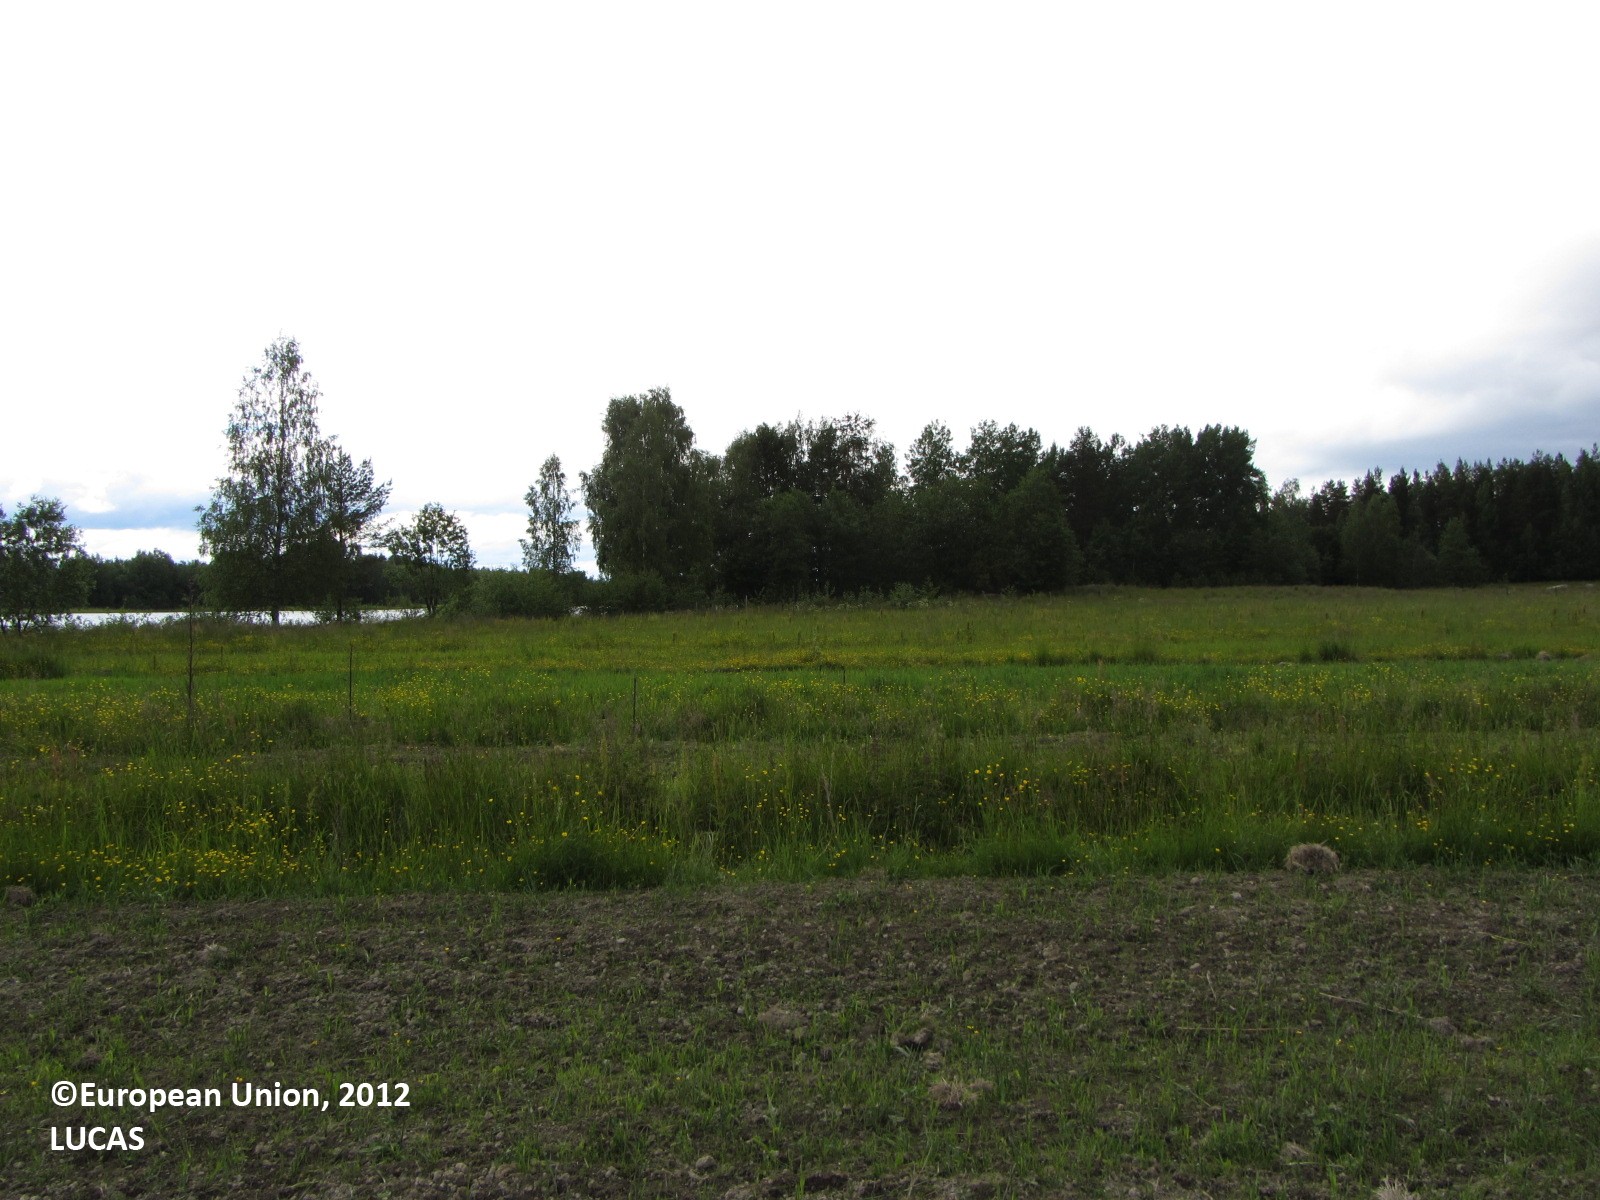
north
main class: Grassland
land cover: Grassland without tree/shrub cover
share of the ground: > 75 %
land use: Agriculture (excluding fallow land and kitchen gardens)
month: June
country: FI
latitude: 62.7595
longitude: 25.5214
